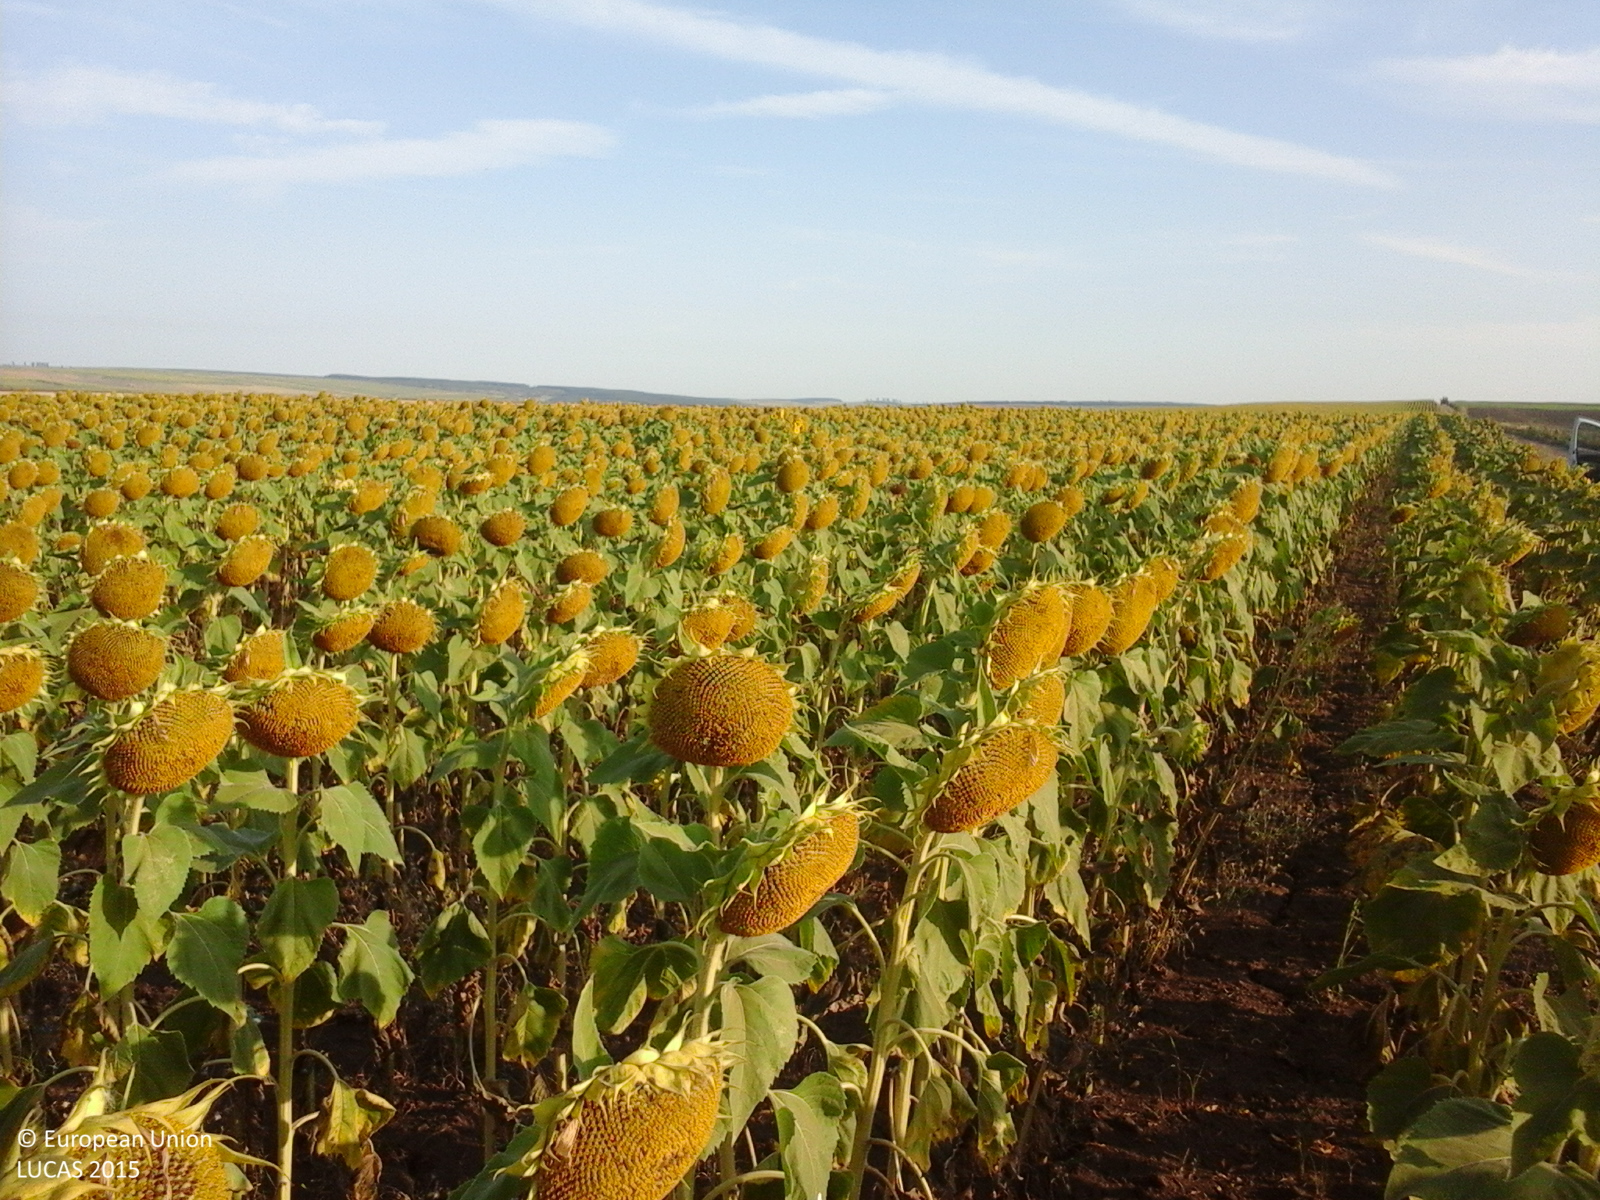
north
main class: Cropland
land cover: Sunflower
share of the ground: > 75 %
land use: Agriculture (excluding fallow land and kitchen gardens)
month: July
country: RO
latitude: 45.9654
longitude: 27.8077
